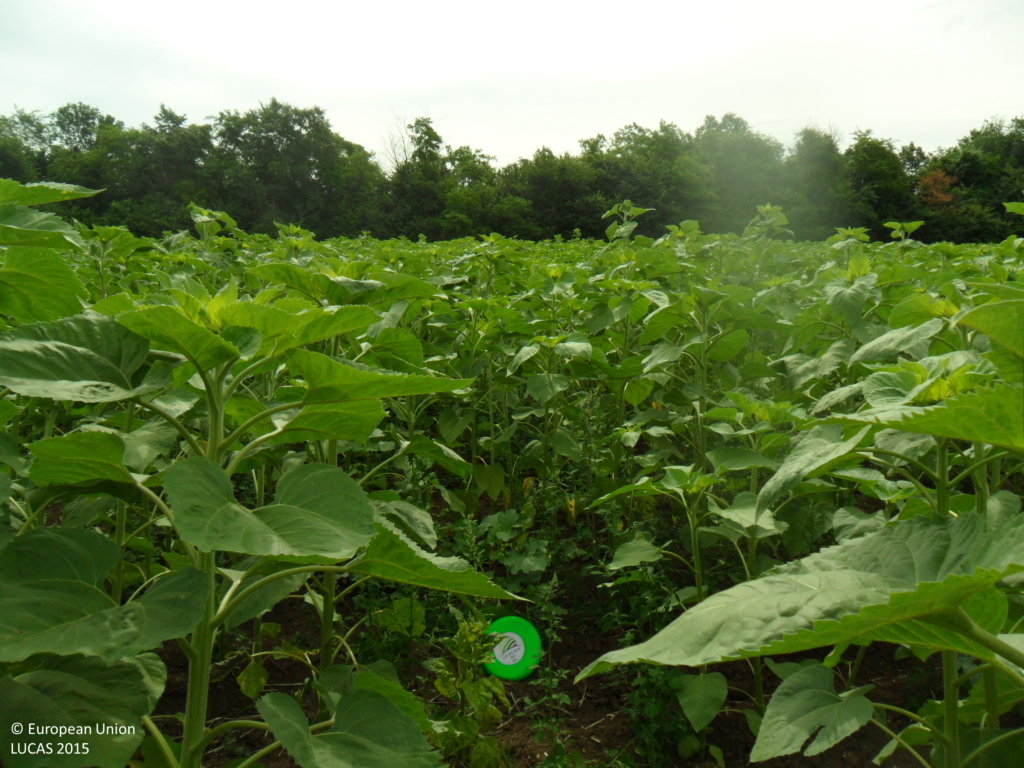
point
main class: Cropland
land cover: Sunflower
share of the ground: > 75 %
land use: Agriculture (excluding fallow land and kitchen gardens)
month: June
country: BG
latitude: 43.7105
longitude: 26.9857
